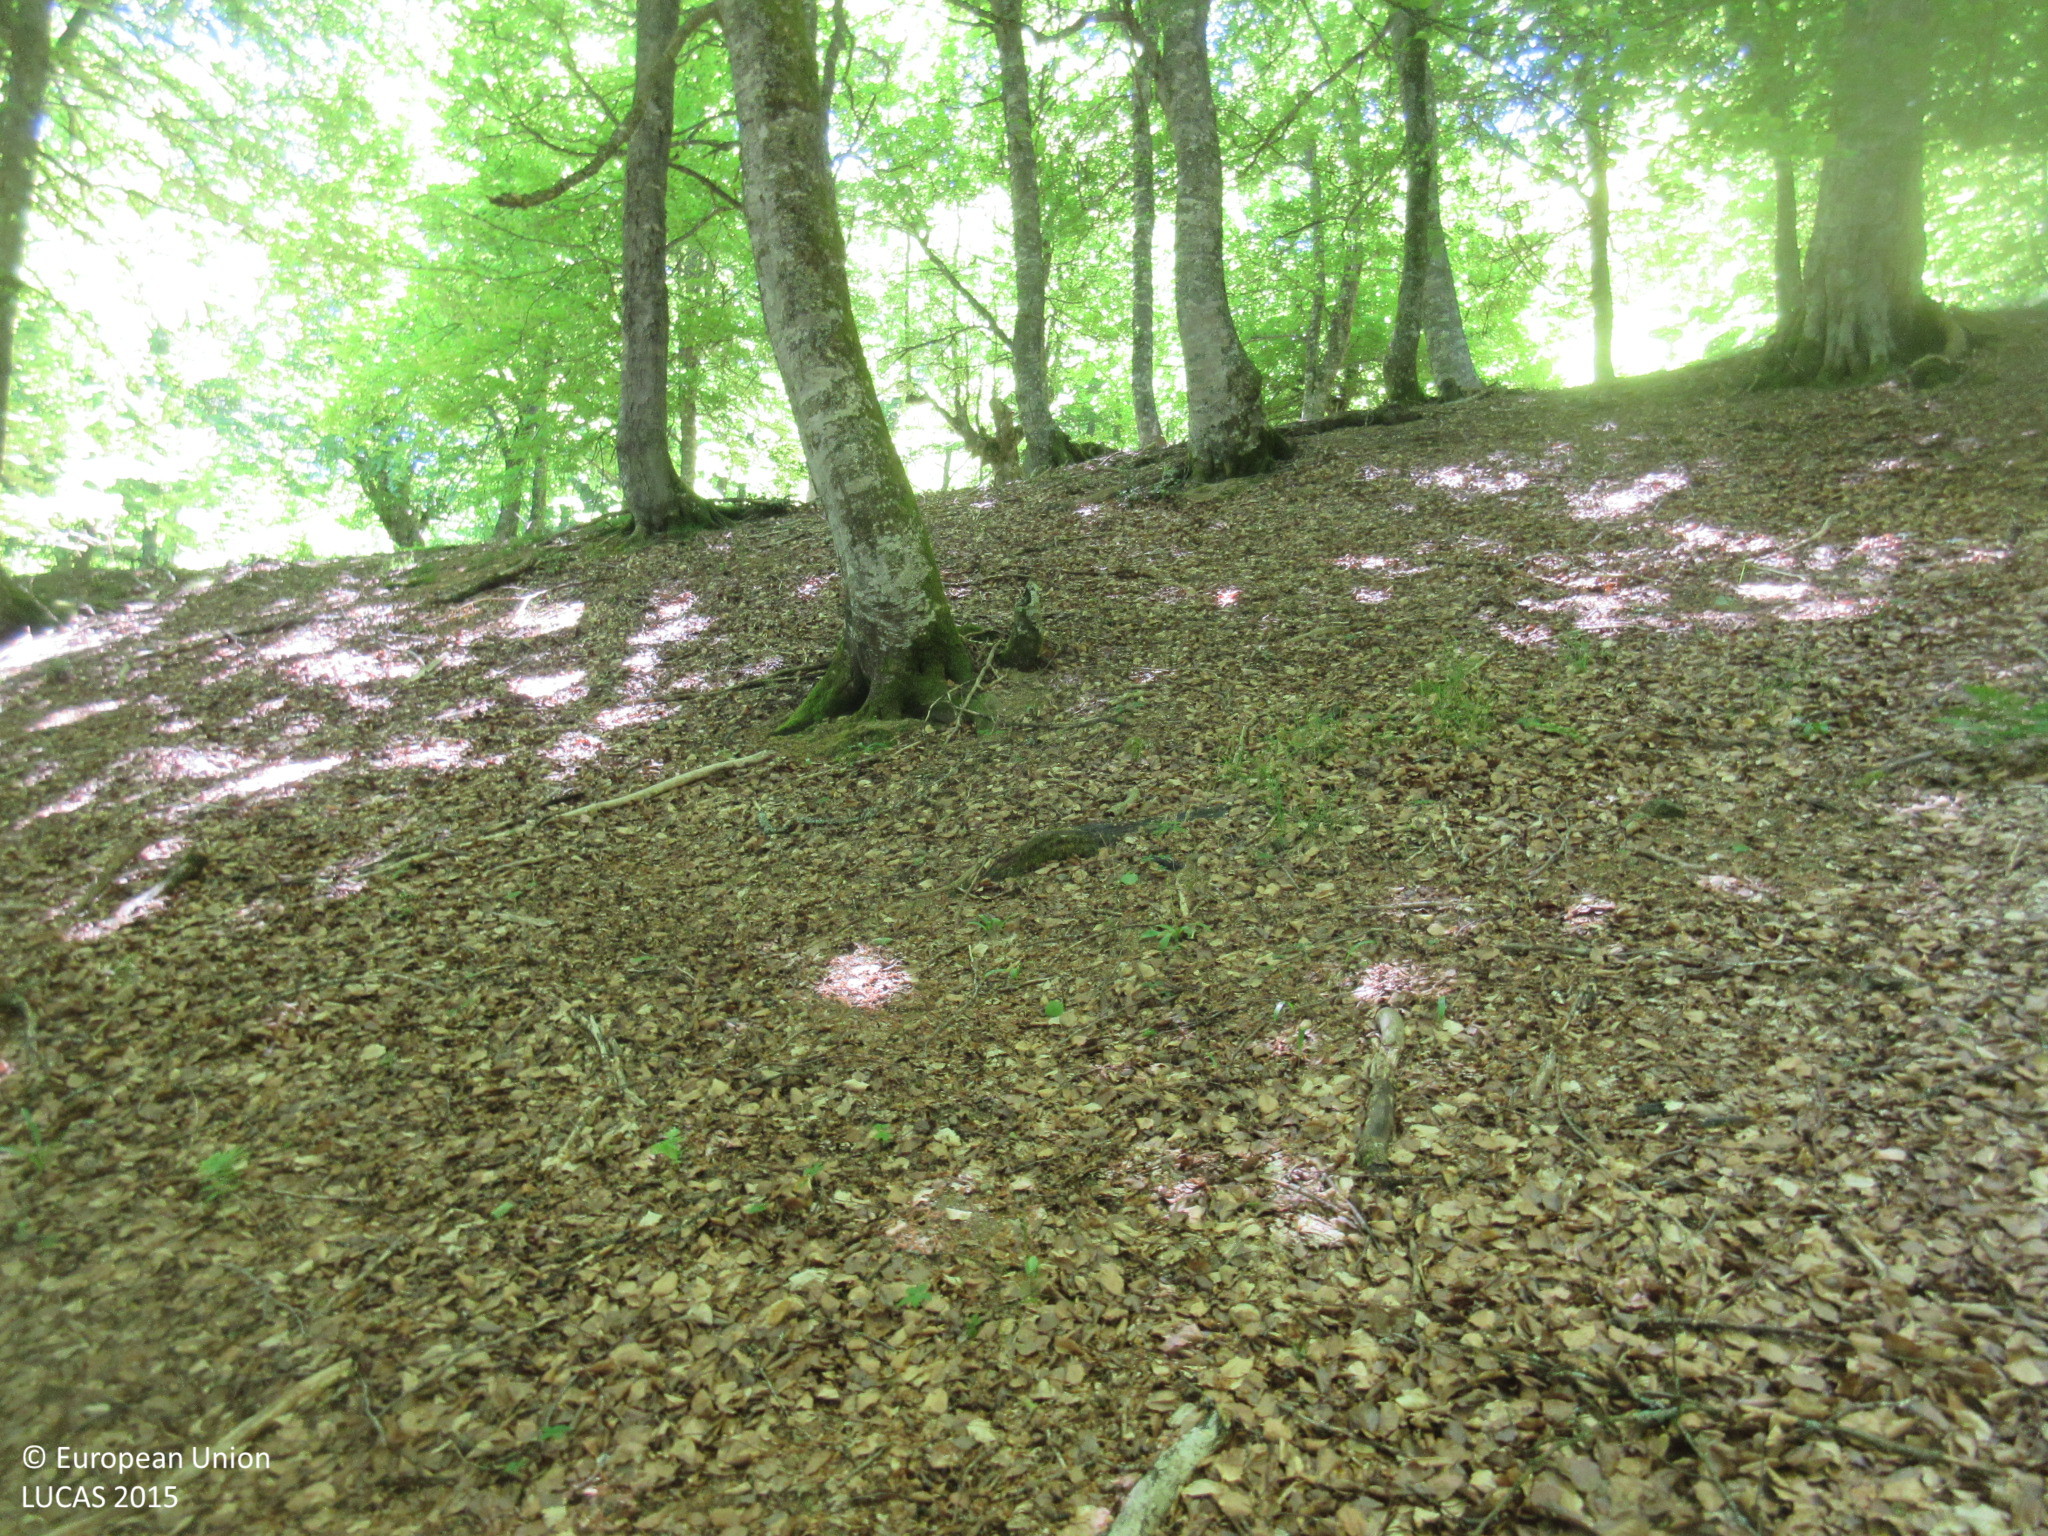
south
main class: Woodland
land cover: Broadleaved woodland
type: beech forest
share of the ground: > 75 %
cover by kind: broadleaved forest trees 95 %, unconsolidated bare surface 5 %
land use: Semi-natural and natural areas not in use
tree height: > 5 m
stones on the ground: 10 - 25 %
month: June
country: ES
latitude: 43.0782
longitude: -4.4388
